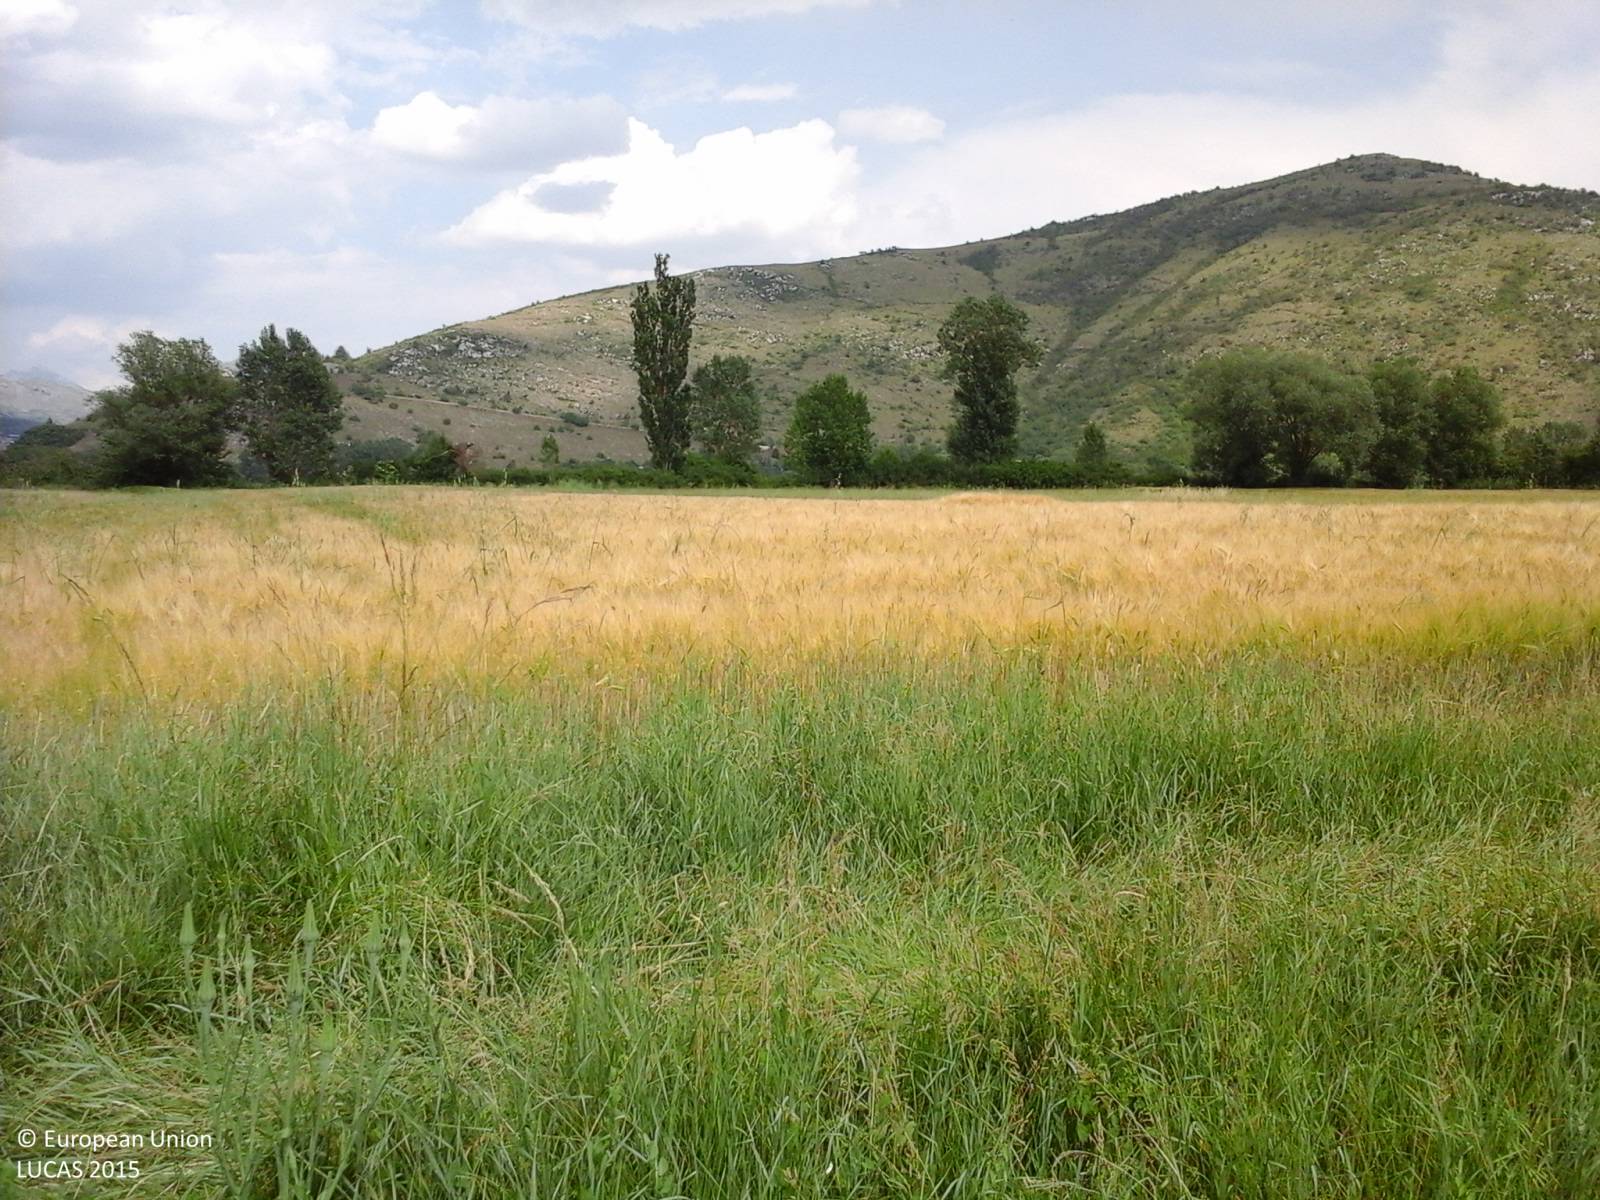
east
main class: Cropland
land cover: Common wheat
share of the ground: > 75 %
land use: Agriculture (excluding fallow land and kitchen gardens)
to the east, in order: Common wheat; Grass margins; Tracks; Grass margins; Maize; Shrubland with sparse tree cover; Tracks; Barley; Grassland without tree/shrub cover; Maize; Grass margins; Mixed cereals for fodder
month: June
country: IT
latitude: 42.0559
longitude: 13.3597
